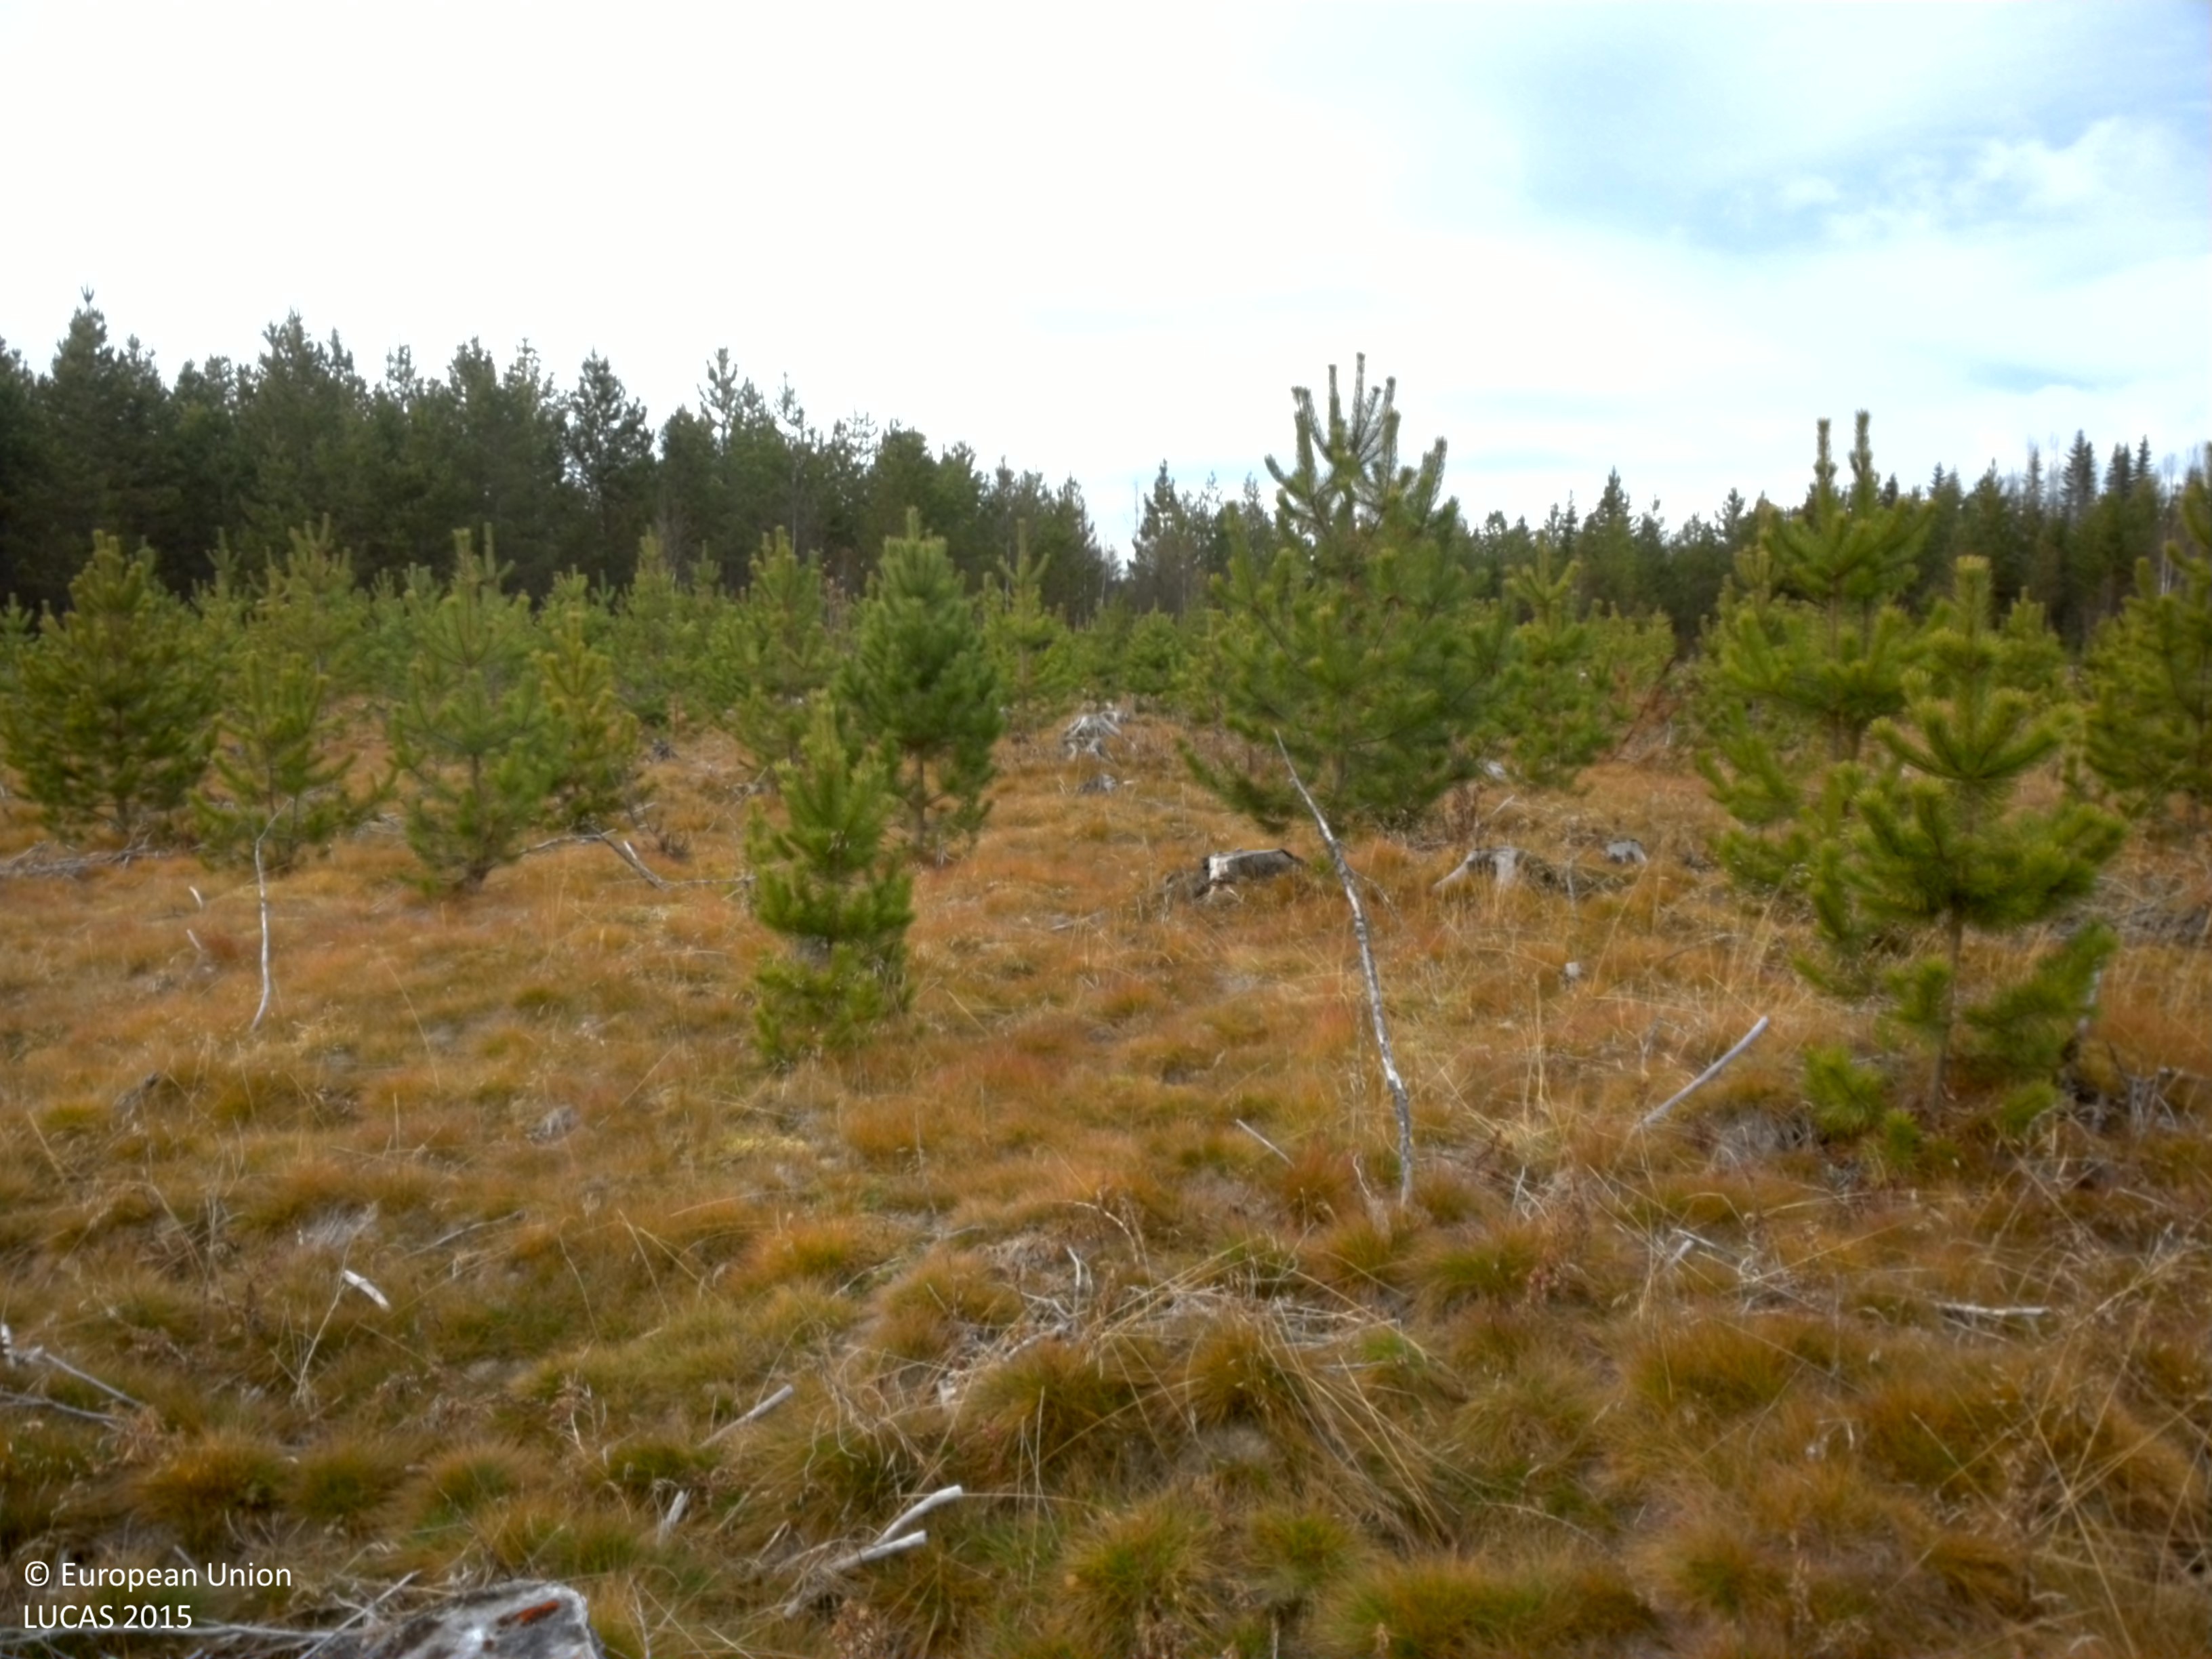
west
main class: Woodland
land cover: Pine dominated coniferous woodland
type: exotic forest
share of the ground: 10 - 25 %
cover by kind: herbaceous plants 85 %, coniferous forest trees 10 %, lichens and mosses 5 %
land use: Forestry
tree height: < 5 m
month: October
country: SE
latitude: 64.5764
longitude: 16.4184
